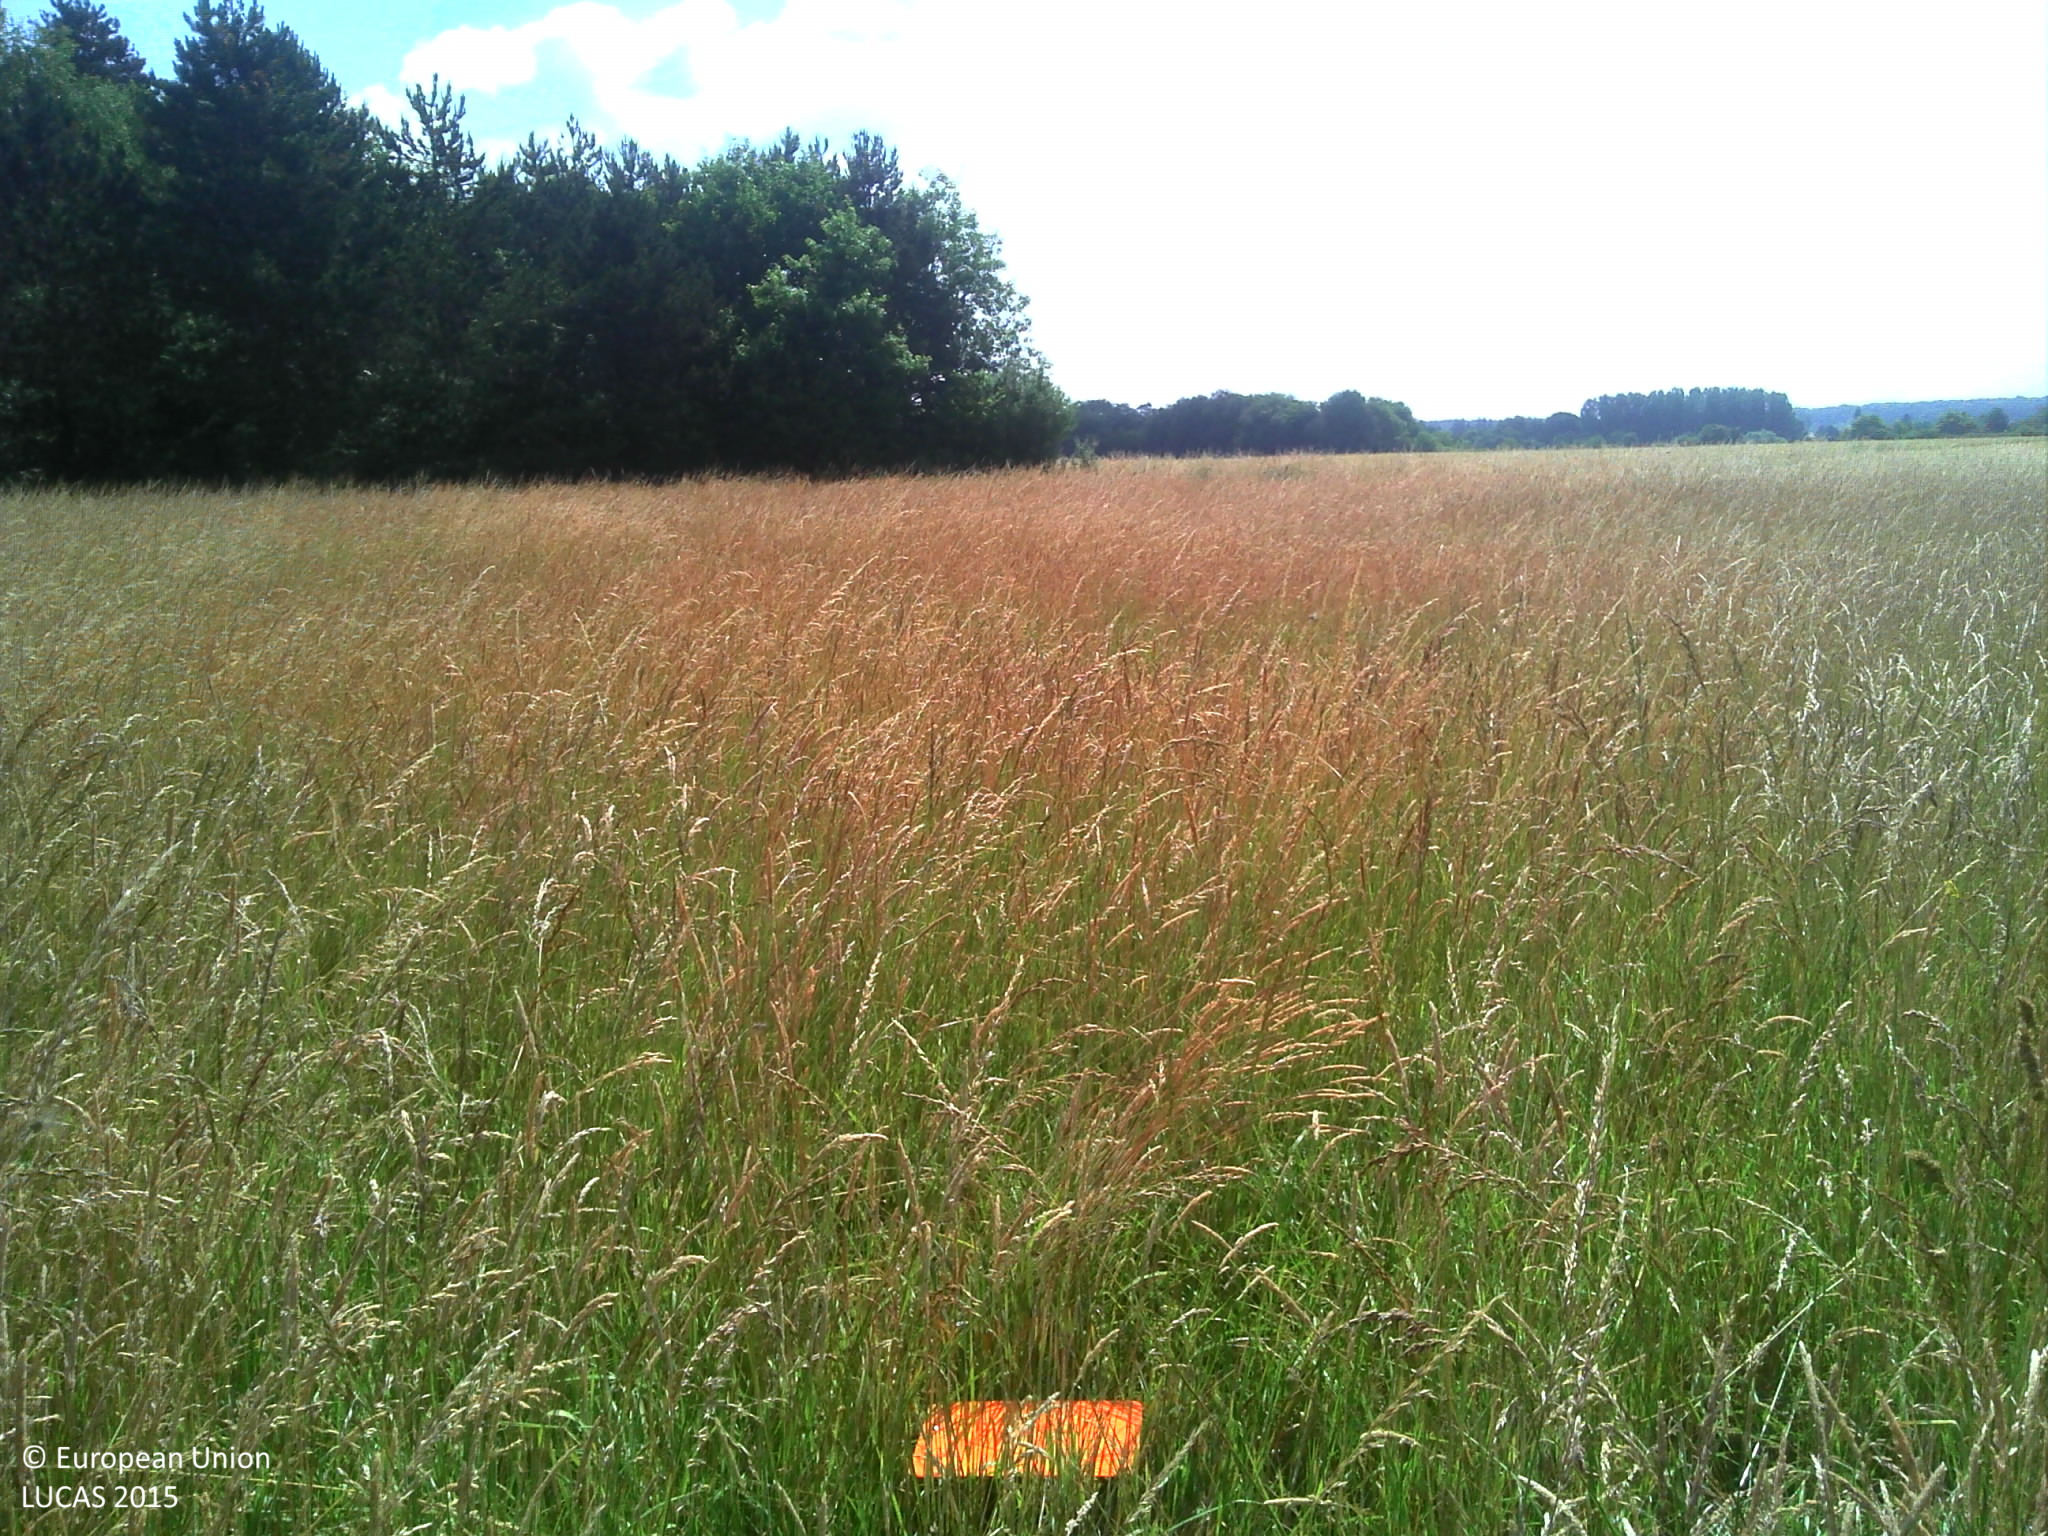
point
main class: Grassland
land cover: Grassland without tree/shrub cover
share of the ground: > 75 %
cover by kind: herbaceous plants 100 %
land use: Agriculture (excluding fallow land and kitchen gardens)
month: June
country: FR
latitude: 47.6022
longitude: 1.4596
